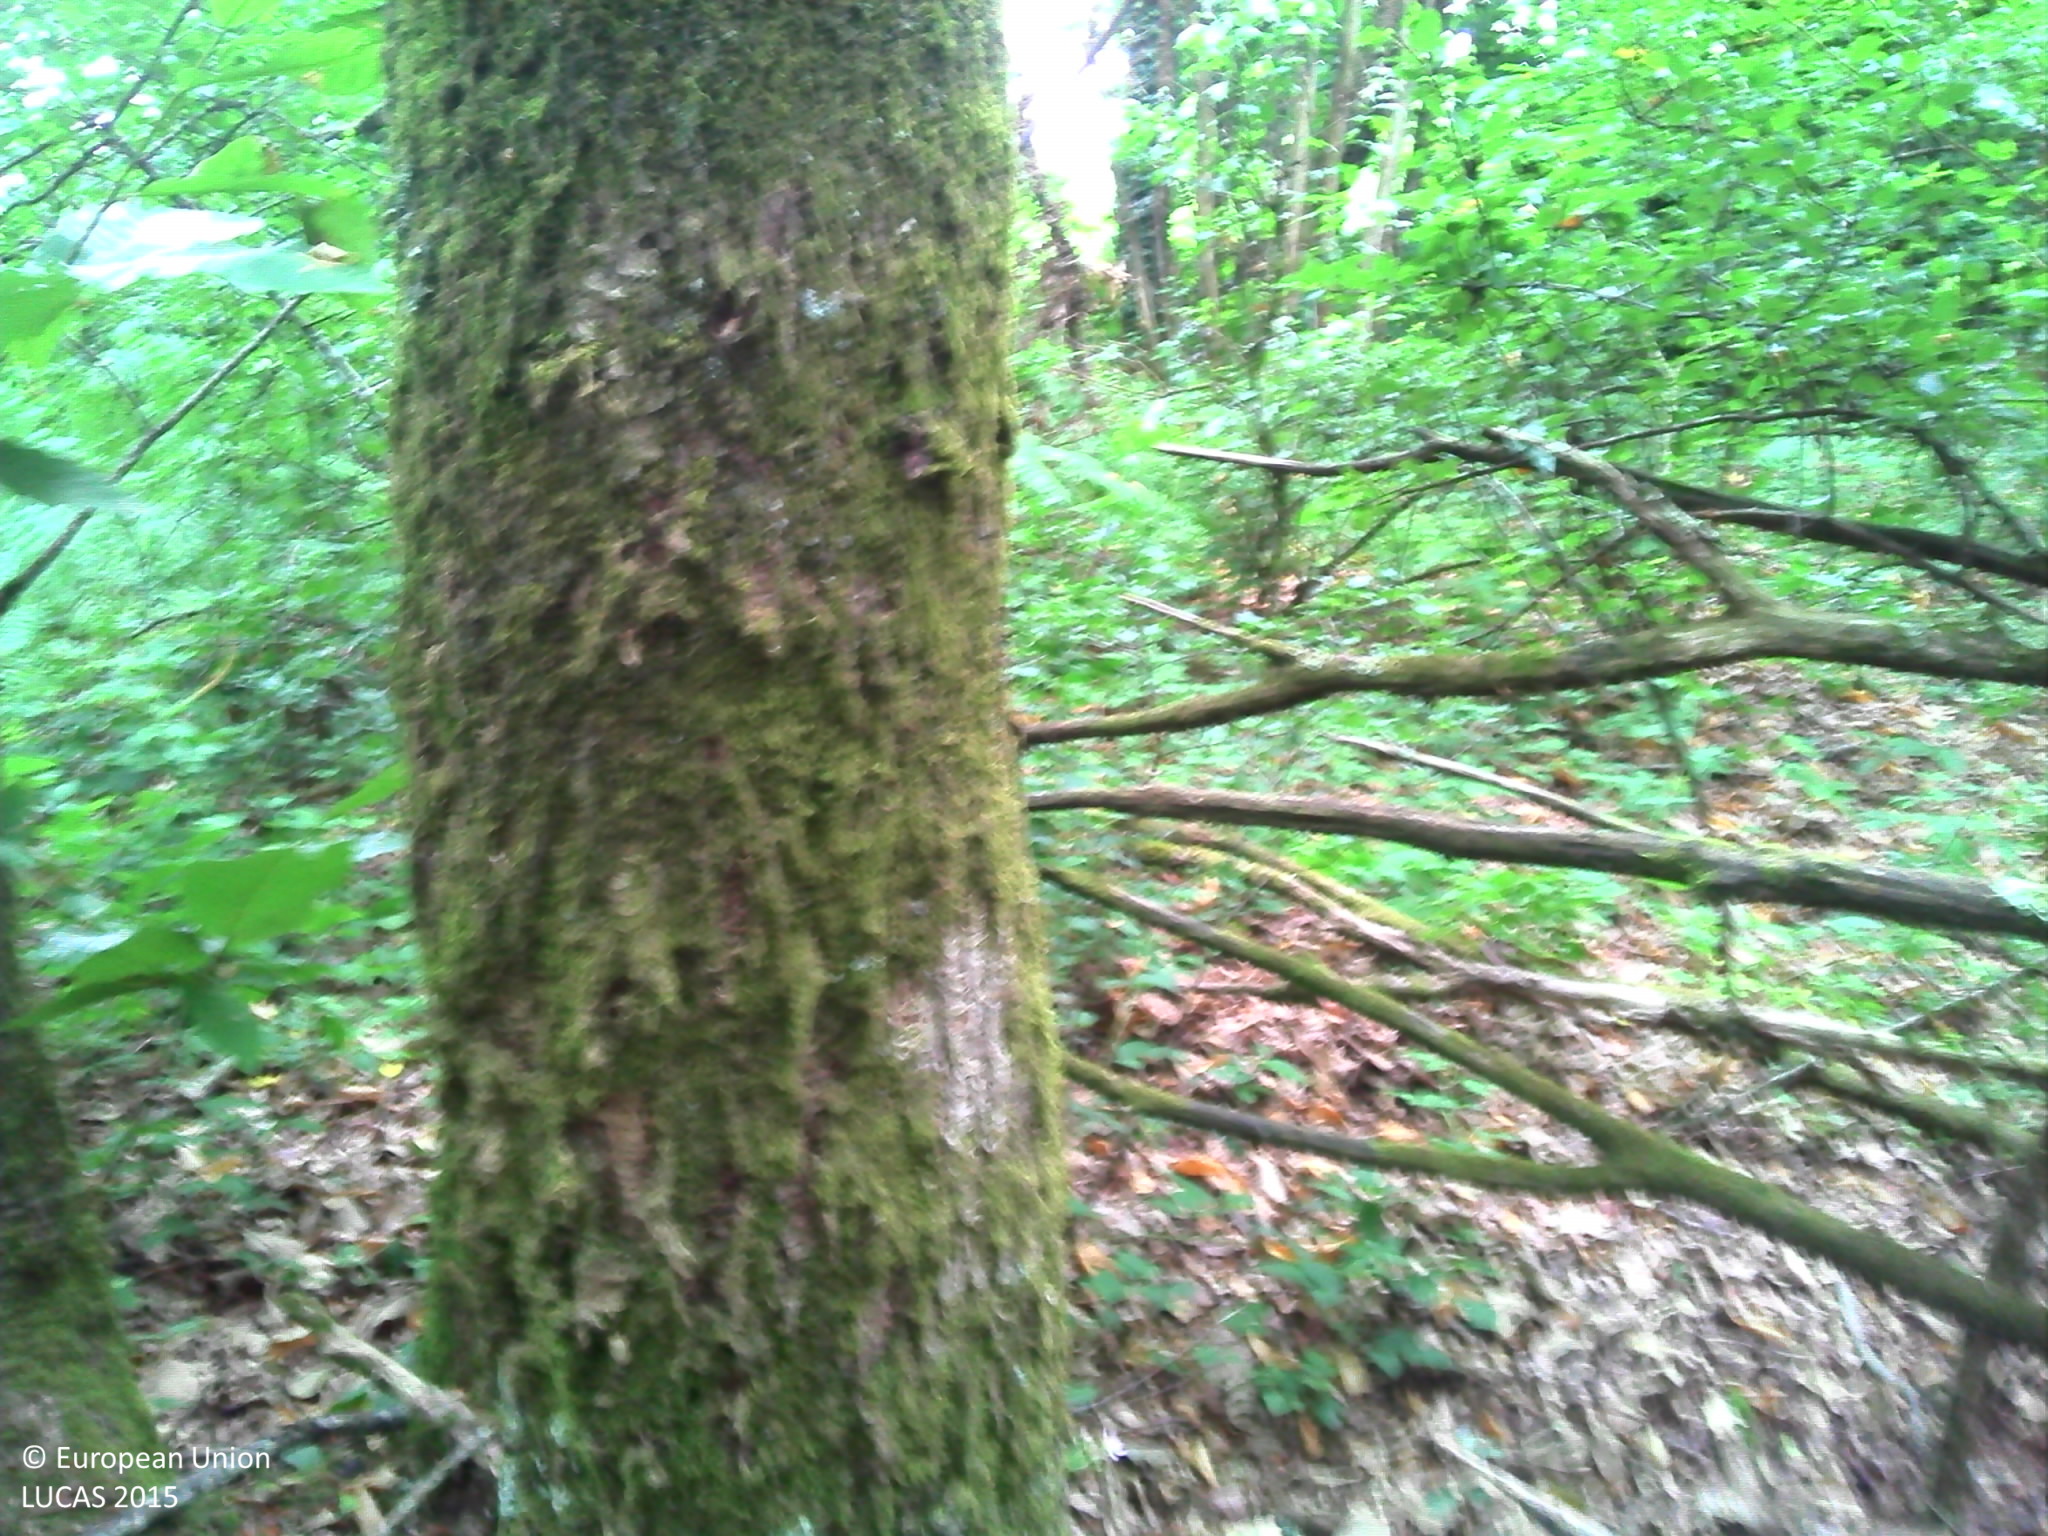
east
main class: Woodland
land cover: Broadleaved woodland
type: thermophilous deciduous forest
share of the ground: > 75 %
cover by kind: broadleaved forest trees 80 %, herbaceous plants 15 %, shrubs 5 %
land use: Forestry
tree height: > 5 m
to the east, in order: Broadleaved woodland; Ditches and canals; Maize; Electric lines; Maize; Grass margins; Paved roads, cycling and walking lanes; Grass margins; Dry pulses
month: July
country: FR
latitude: 47.8522
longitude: -3.2896
